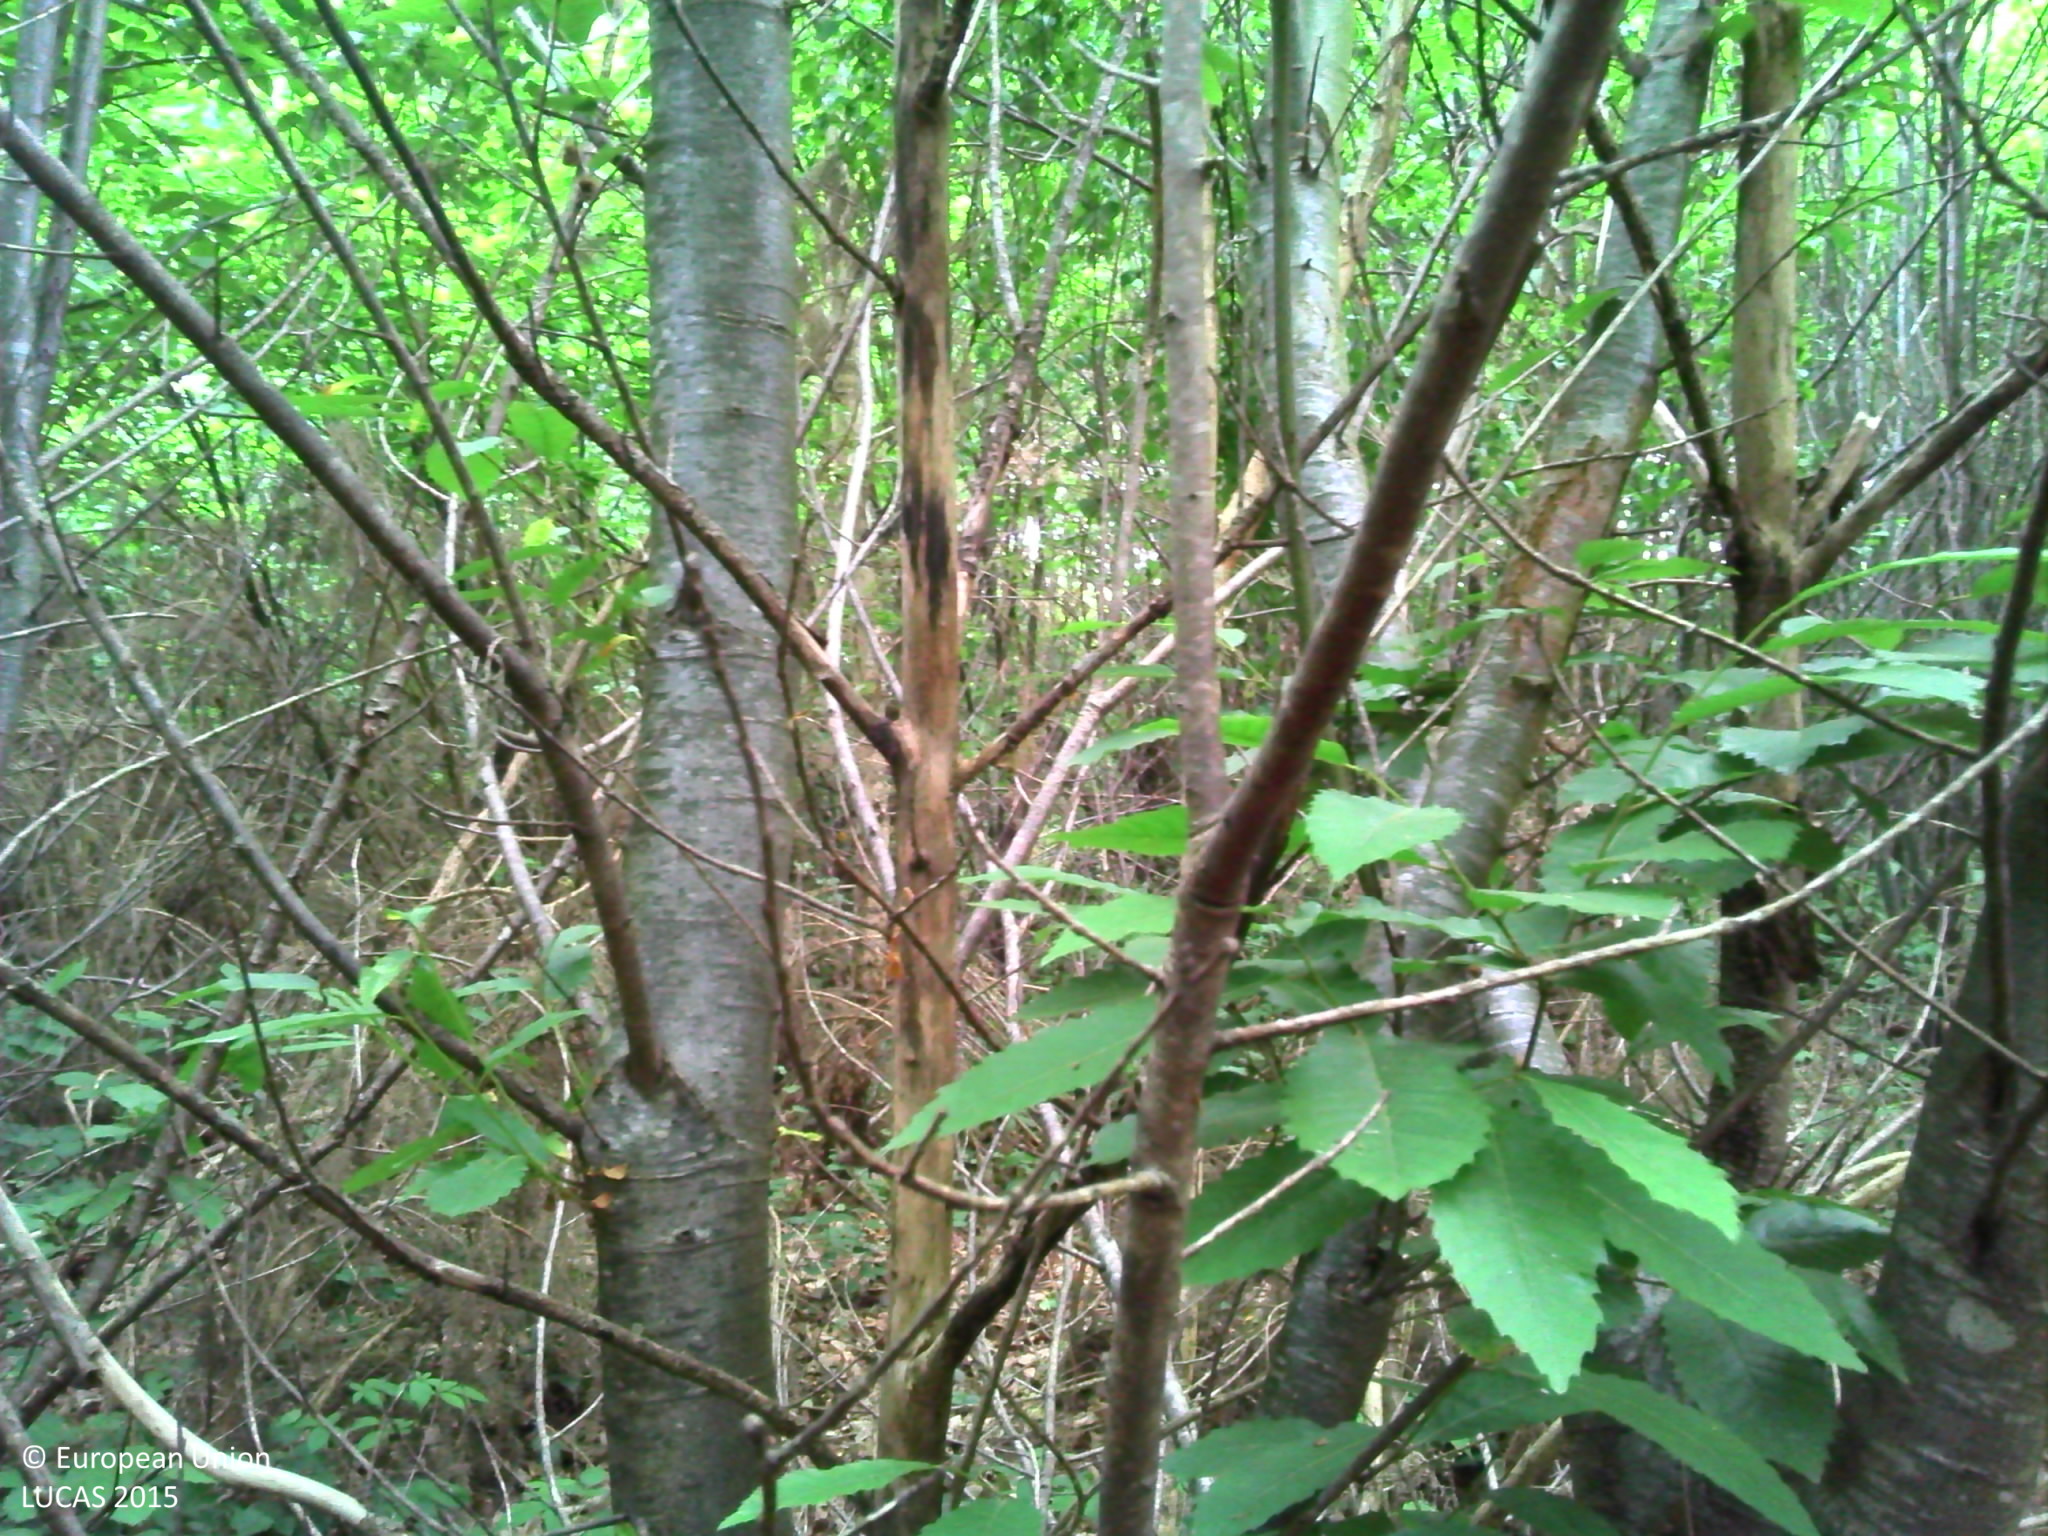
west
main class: Woodland
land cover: Broadleaved woodland
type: thermophilous deciduous forest
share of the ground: > 75 %
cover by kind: broadleaved forest trees 100 %
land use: Forestry
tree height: > 5 m
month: June
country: FR
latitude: 45.9298
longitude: 0.3244
